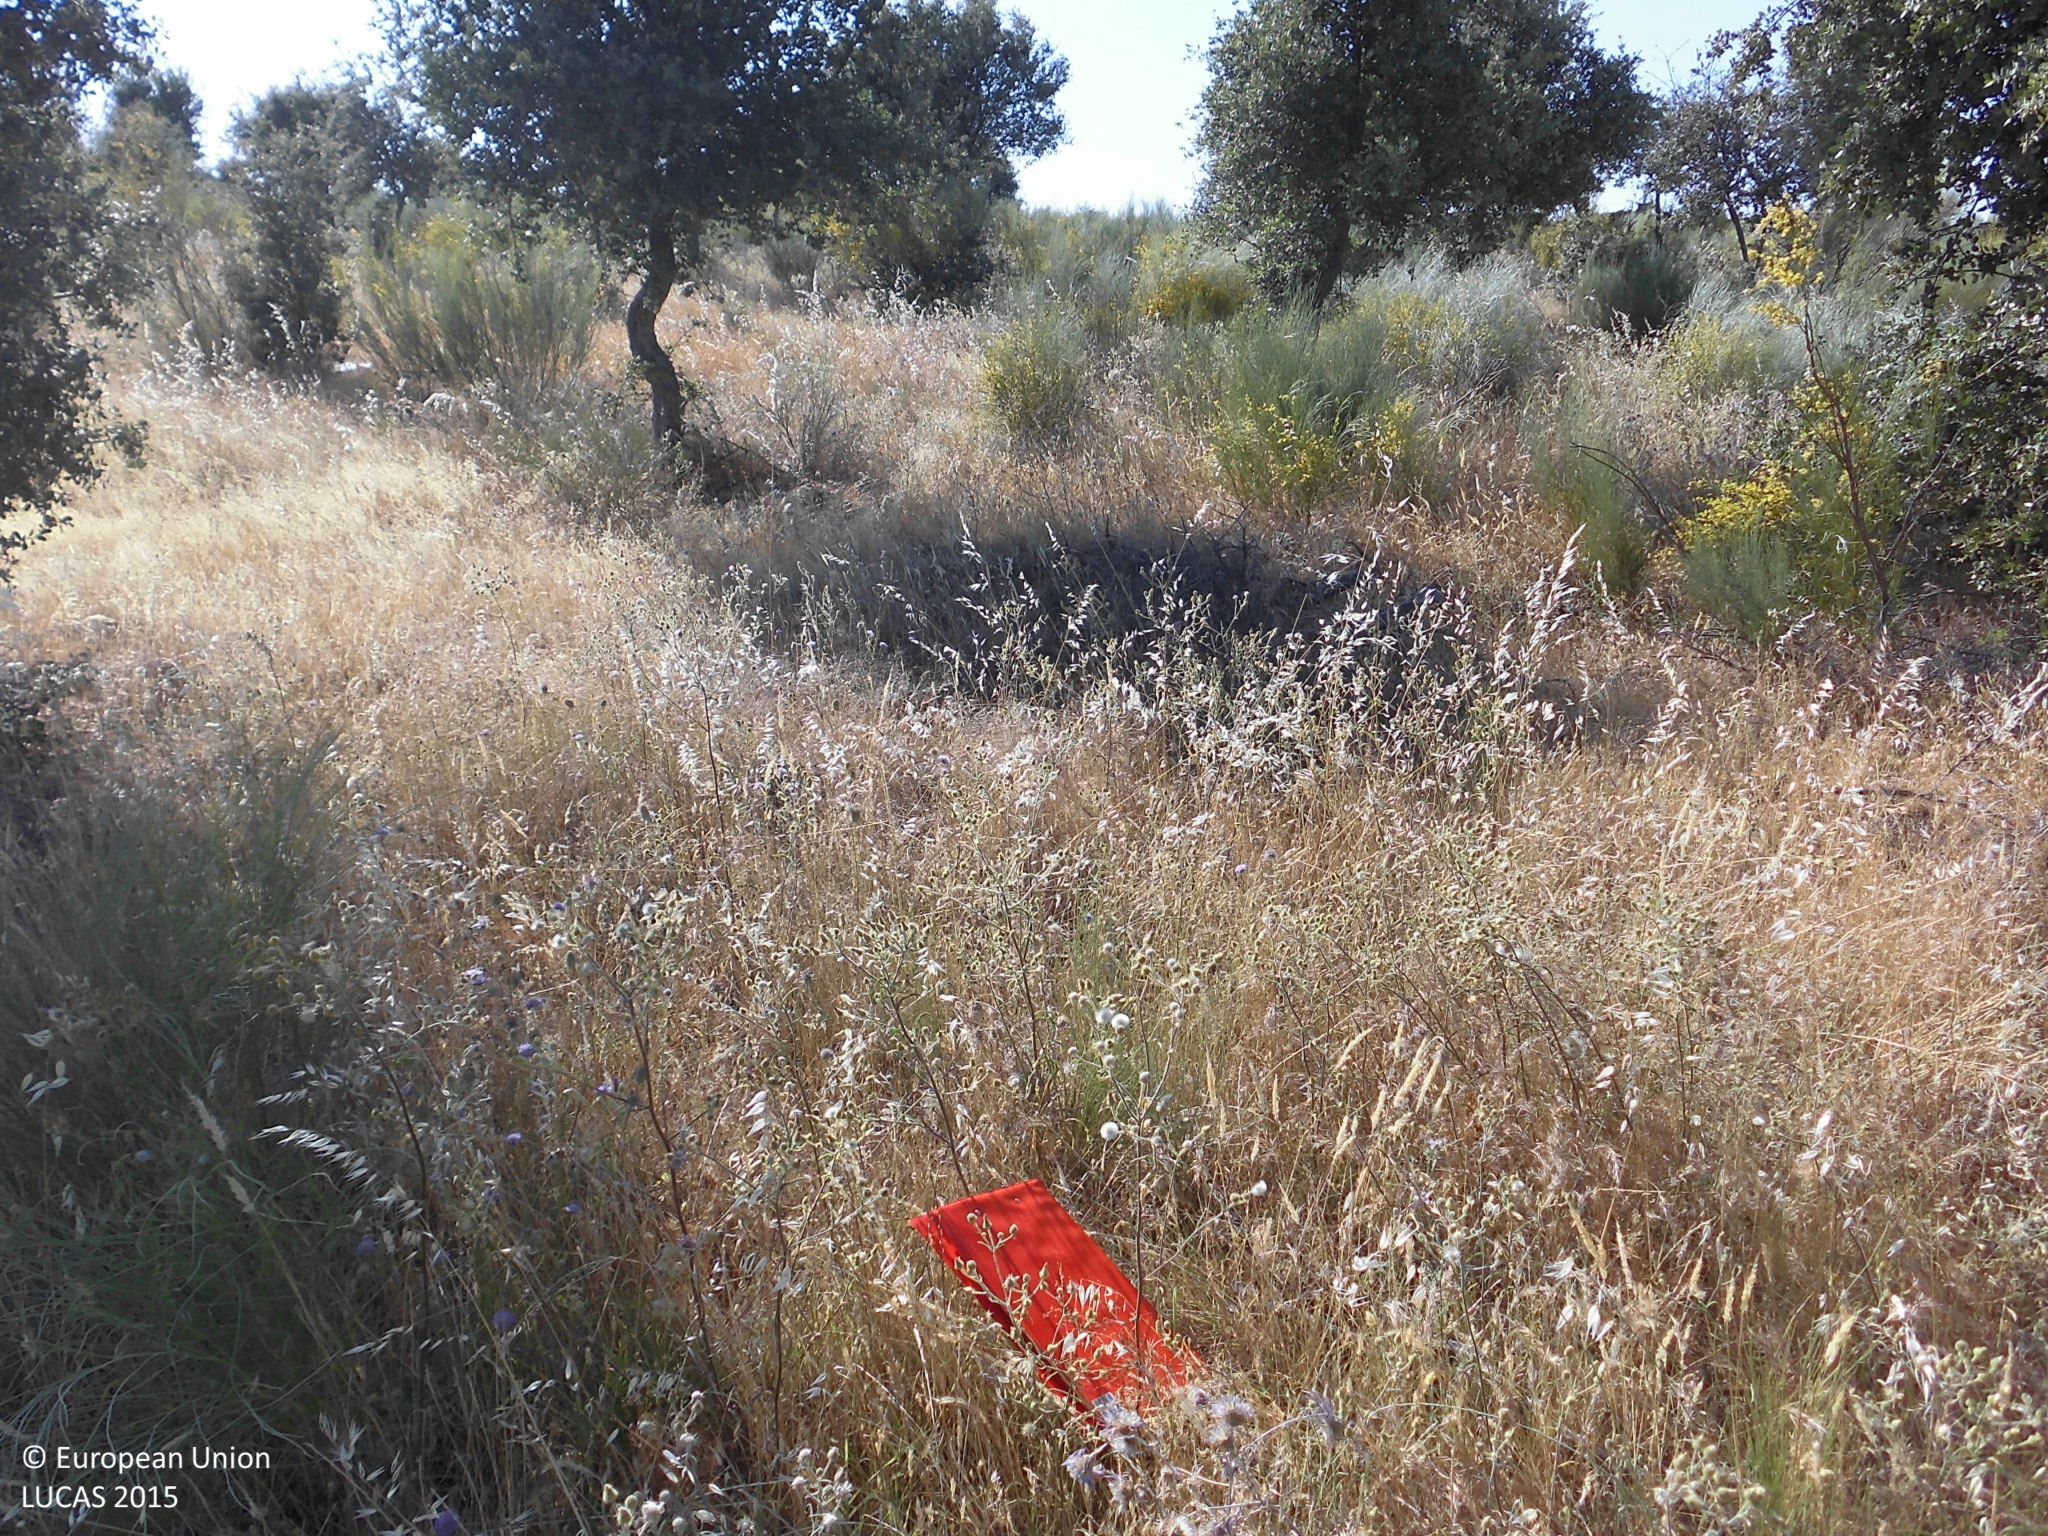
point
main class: Woodland
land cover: Broadleaved woodland
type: broadleaved evergreen forest
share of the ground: 10 - 25 %
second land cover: Grassland without tree/shrub cover
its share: > 75 %
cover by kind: herbaceous plants 70 %, broadleaved forest trees 20 %, shrubs 10 %
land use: Forestry
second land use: Agriculture (excluding fallow land and kitchen gardens)
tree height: < 5 m
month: May
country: ES
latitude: 39.9385
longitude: -6.5452
